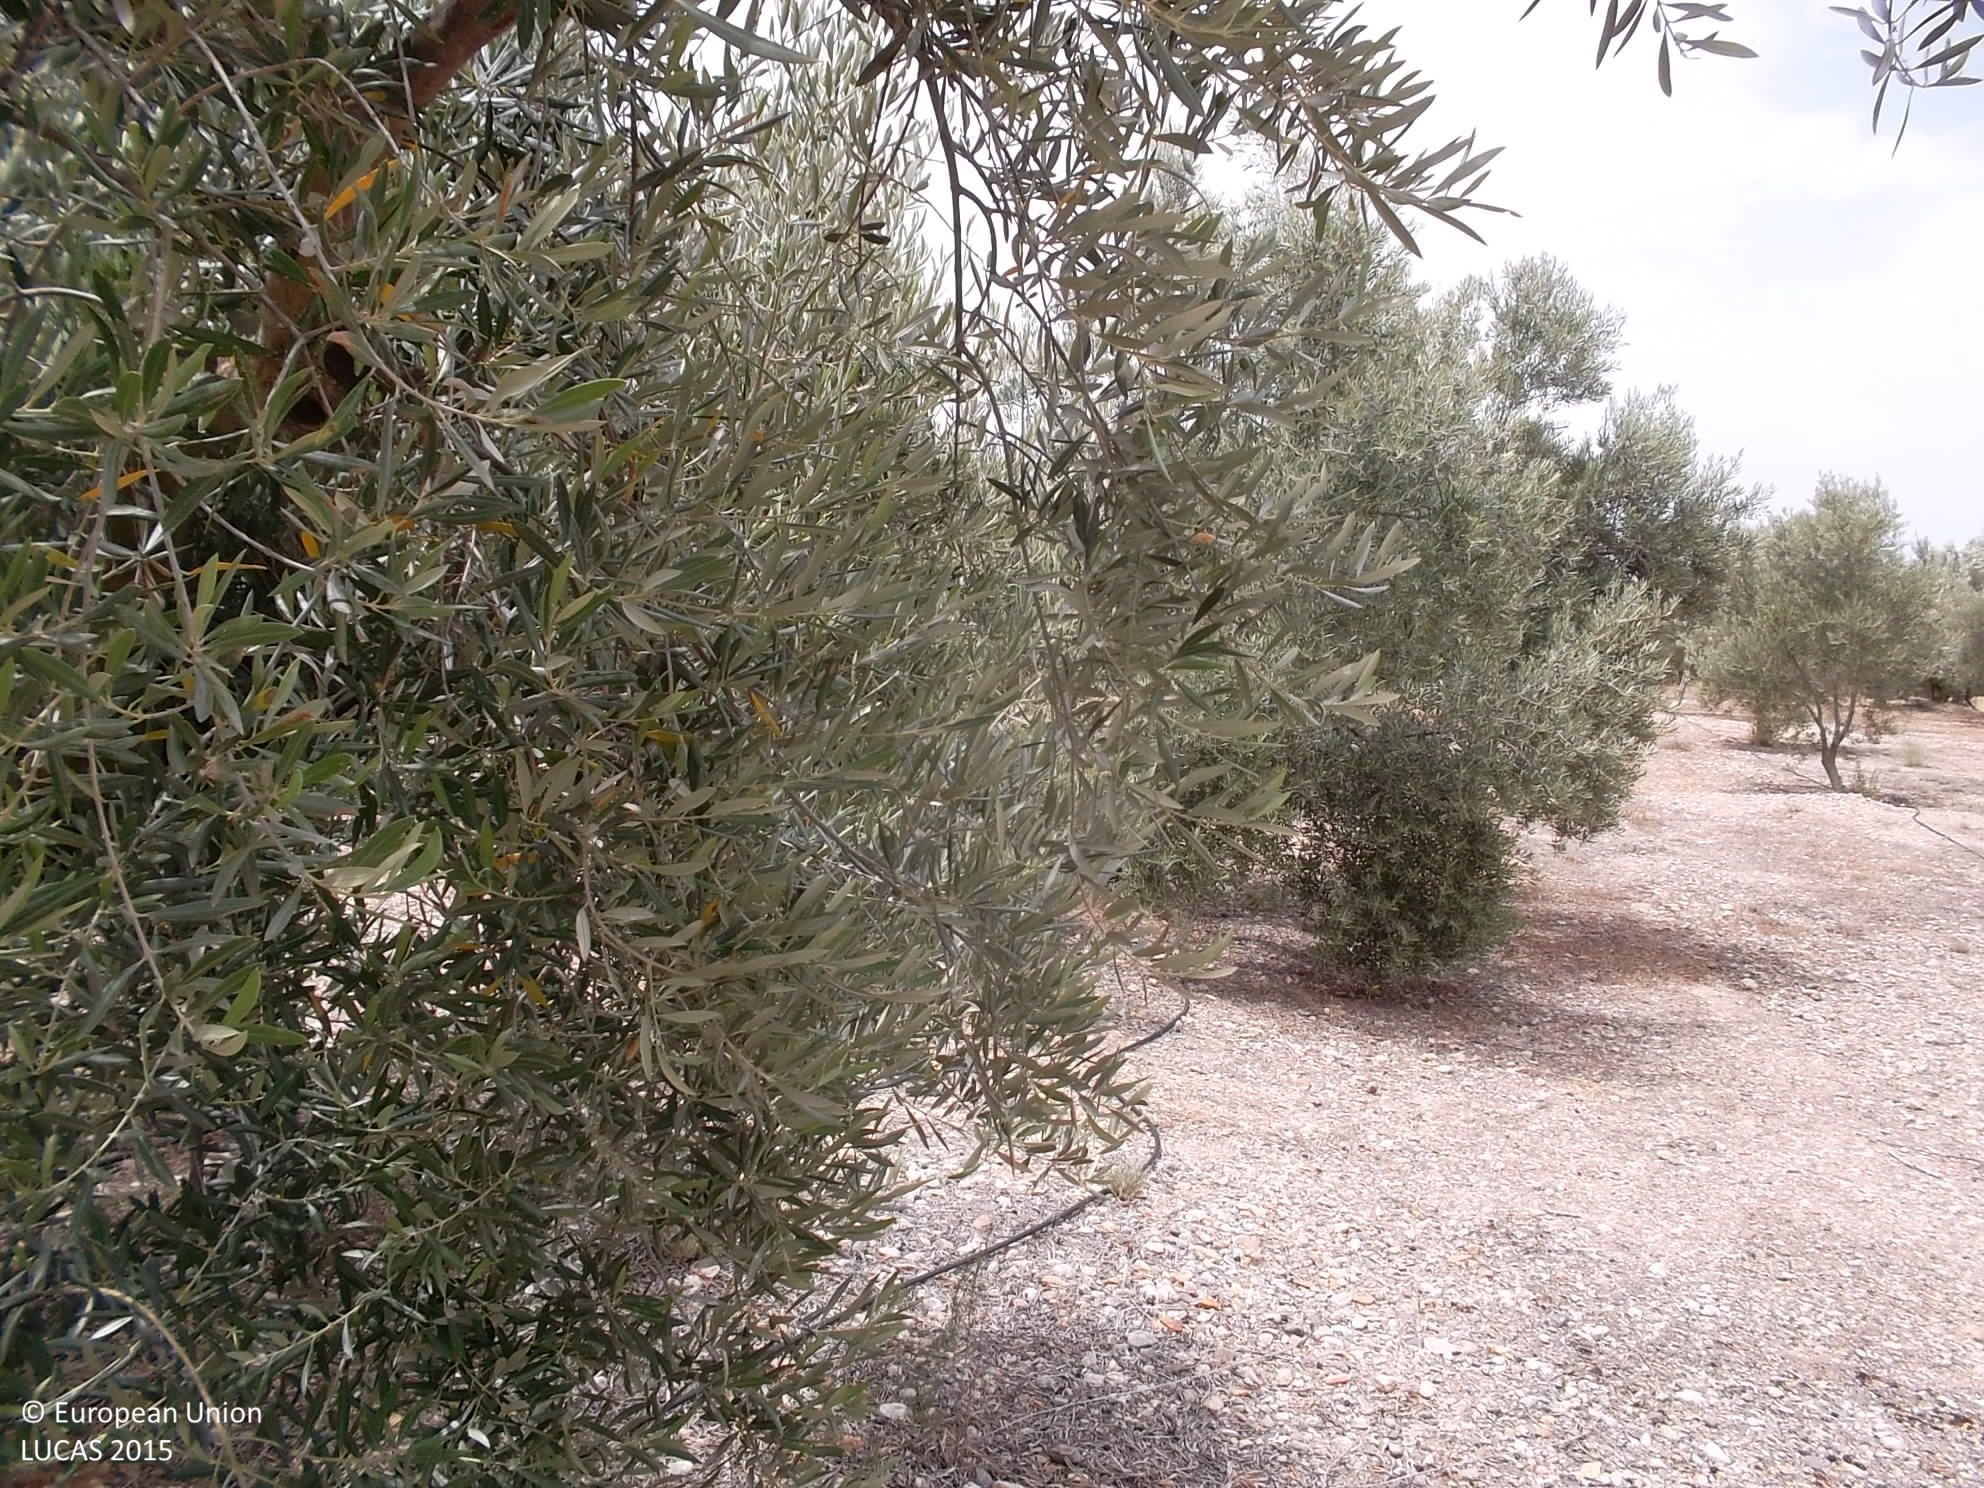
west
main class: Cropland
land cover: Olive groves
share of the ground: 25 - 50 %
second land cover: Other bare soil
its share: > 75 %
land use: Agriculture (excluding fallow land and kitchen gardens)
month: July
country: ES
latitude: 37.5882
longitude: -2.7058
